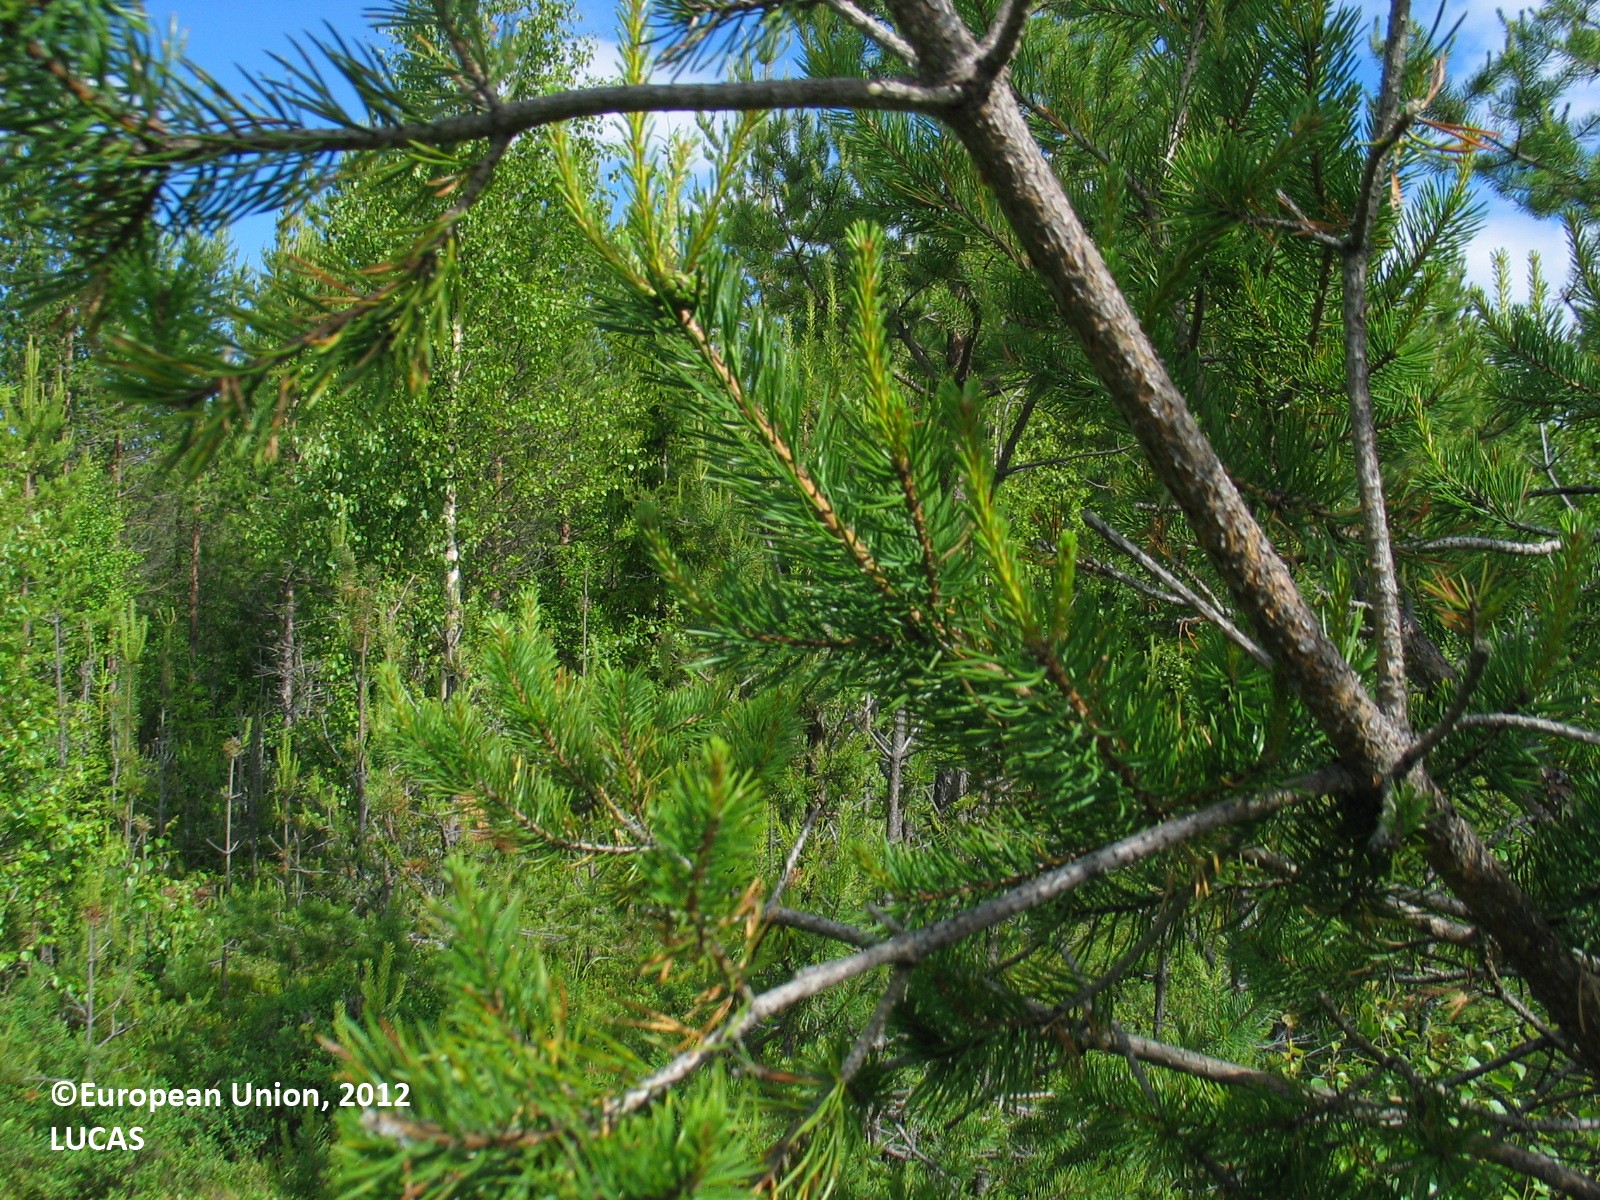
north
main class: Woodland
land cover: Other mixed woodland
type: boreal forest
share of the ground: 25 - 50 %
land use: Forestry
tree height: < 5 m
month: July
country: FI
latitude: 64.7563
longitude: 26.6114
